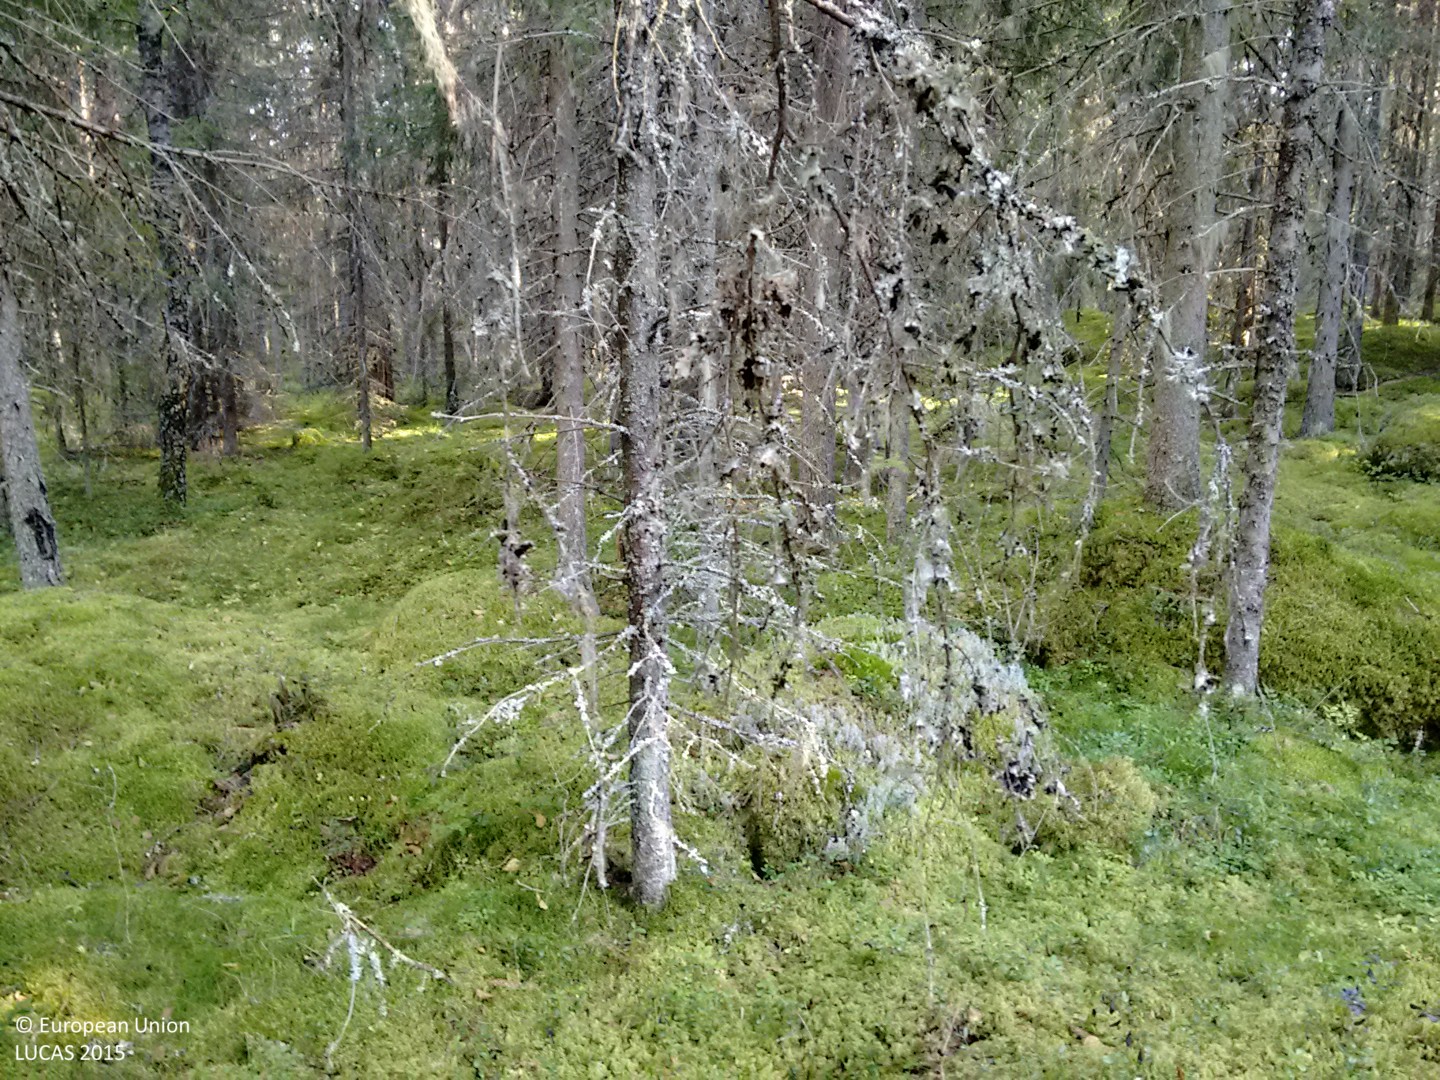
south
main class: Woodland
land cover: Spruce dominated coniferous woodland
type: hemiboreal forest and nemoral coniferous forest and mixed broadleaved-coniferous forest
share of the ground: > 75 %
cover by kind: coniferous forest trees 90 %, shrubs 5 %, lichens and mosses 5 %
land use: Forestry
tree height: > 5 m
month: September
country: FI
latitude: 60.9285
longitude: 21.9597
